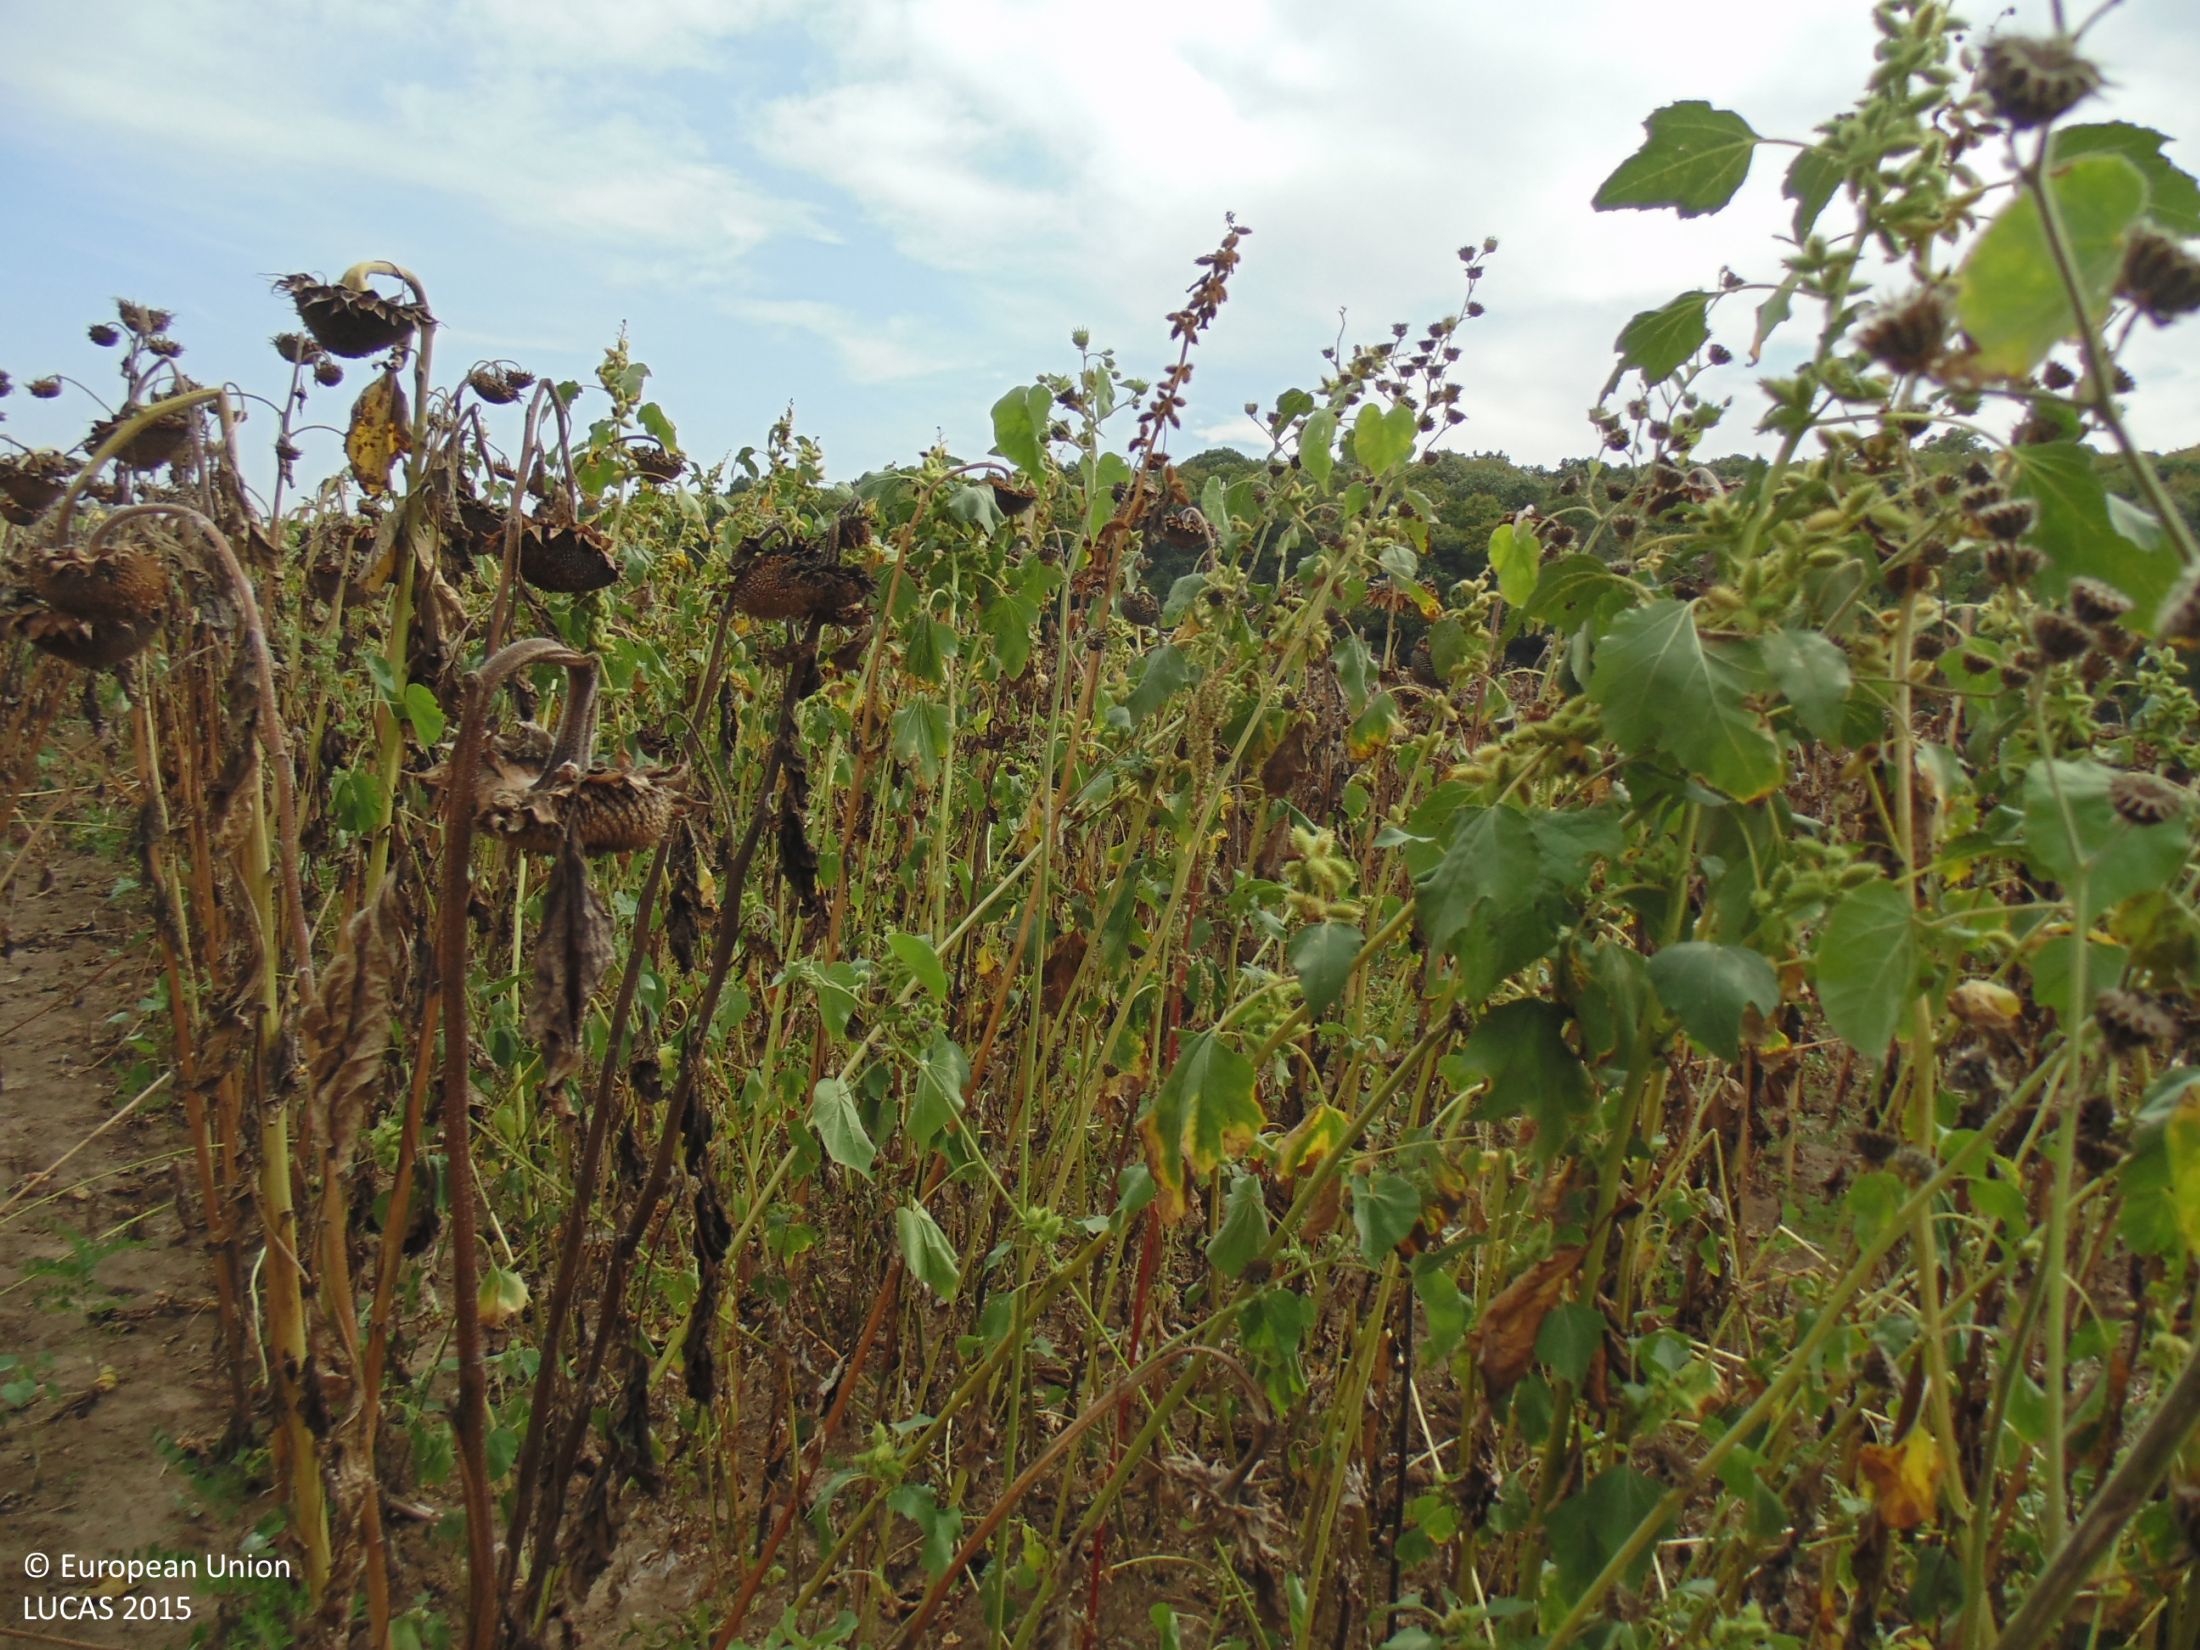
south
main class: Cropland
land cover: Sunflower
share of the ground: > 75 %
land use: Agriculture (excluding fallow land and kitchen gardens)
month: September
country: BG
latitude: 43.9661
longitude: 27.2166
